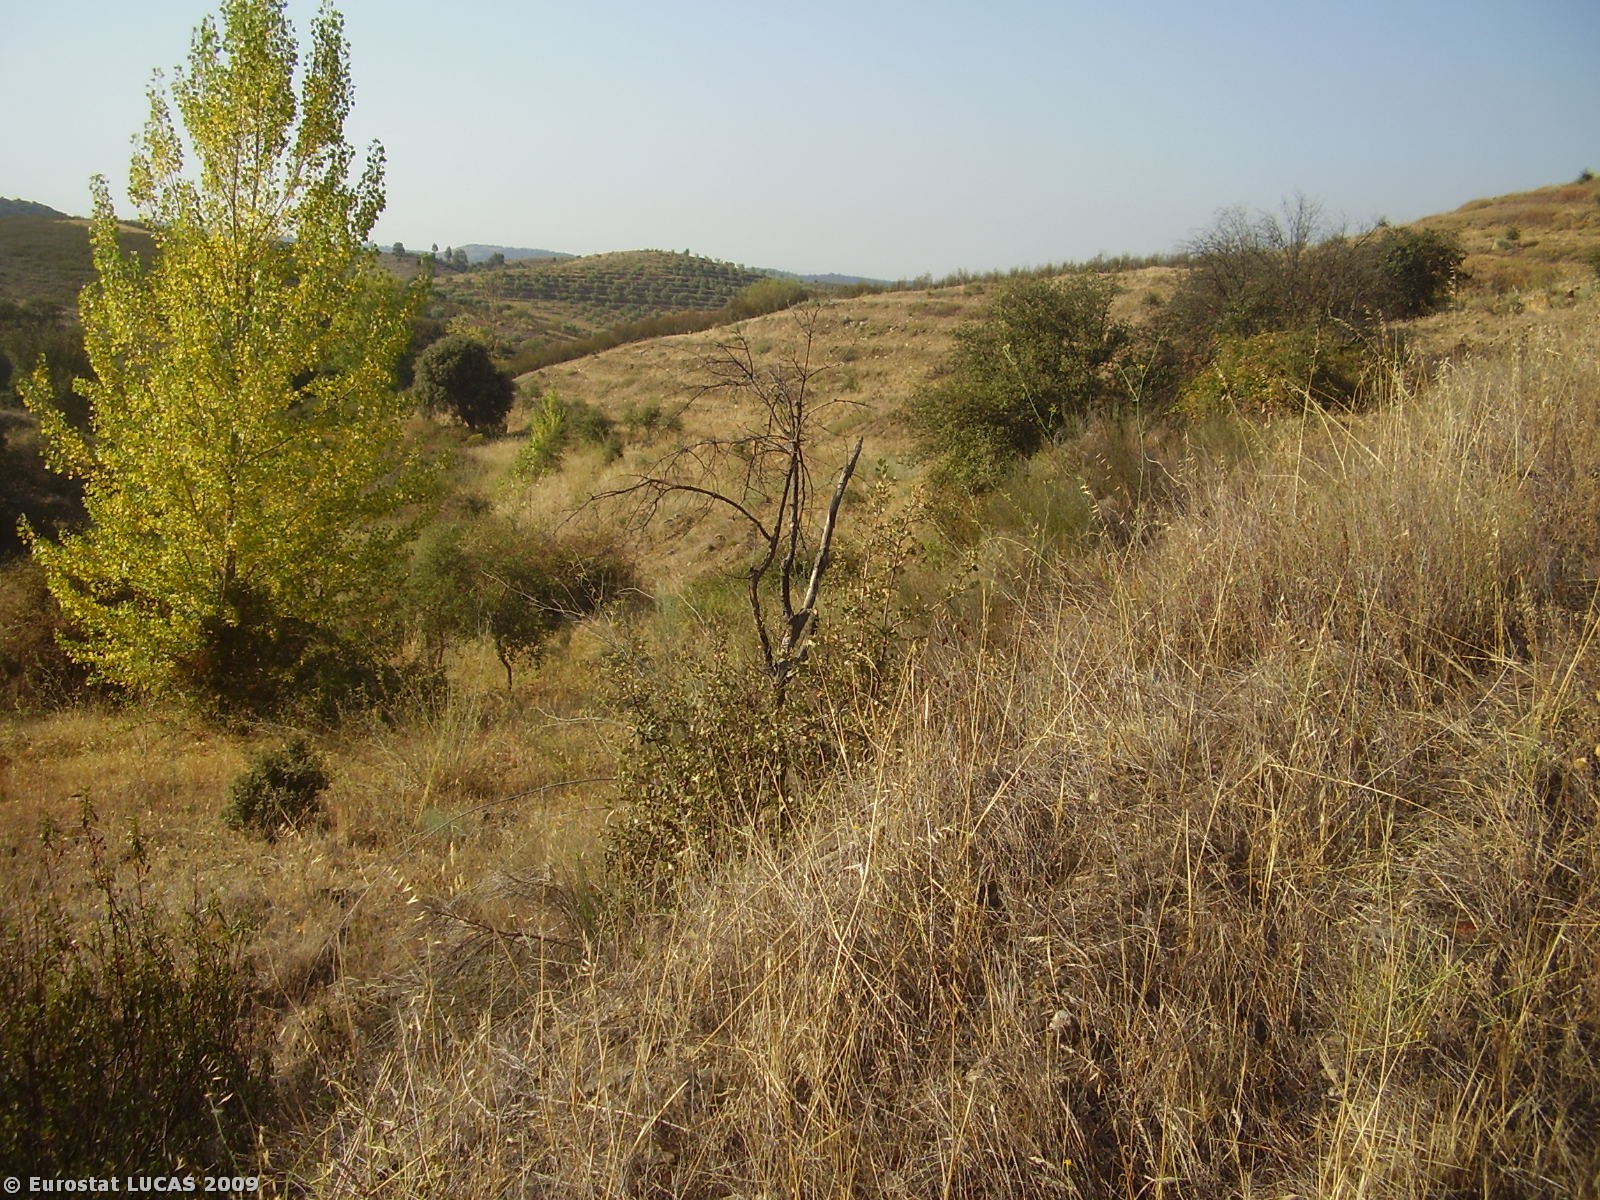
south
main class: Grassland
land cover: Spontaneously vegetated surfaces
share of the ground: > 75 %
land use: Fallow land
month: August
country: PT
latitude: 41.3652
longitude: -7.0291
